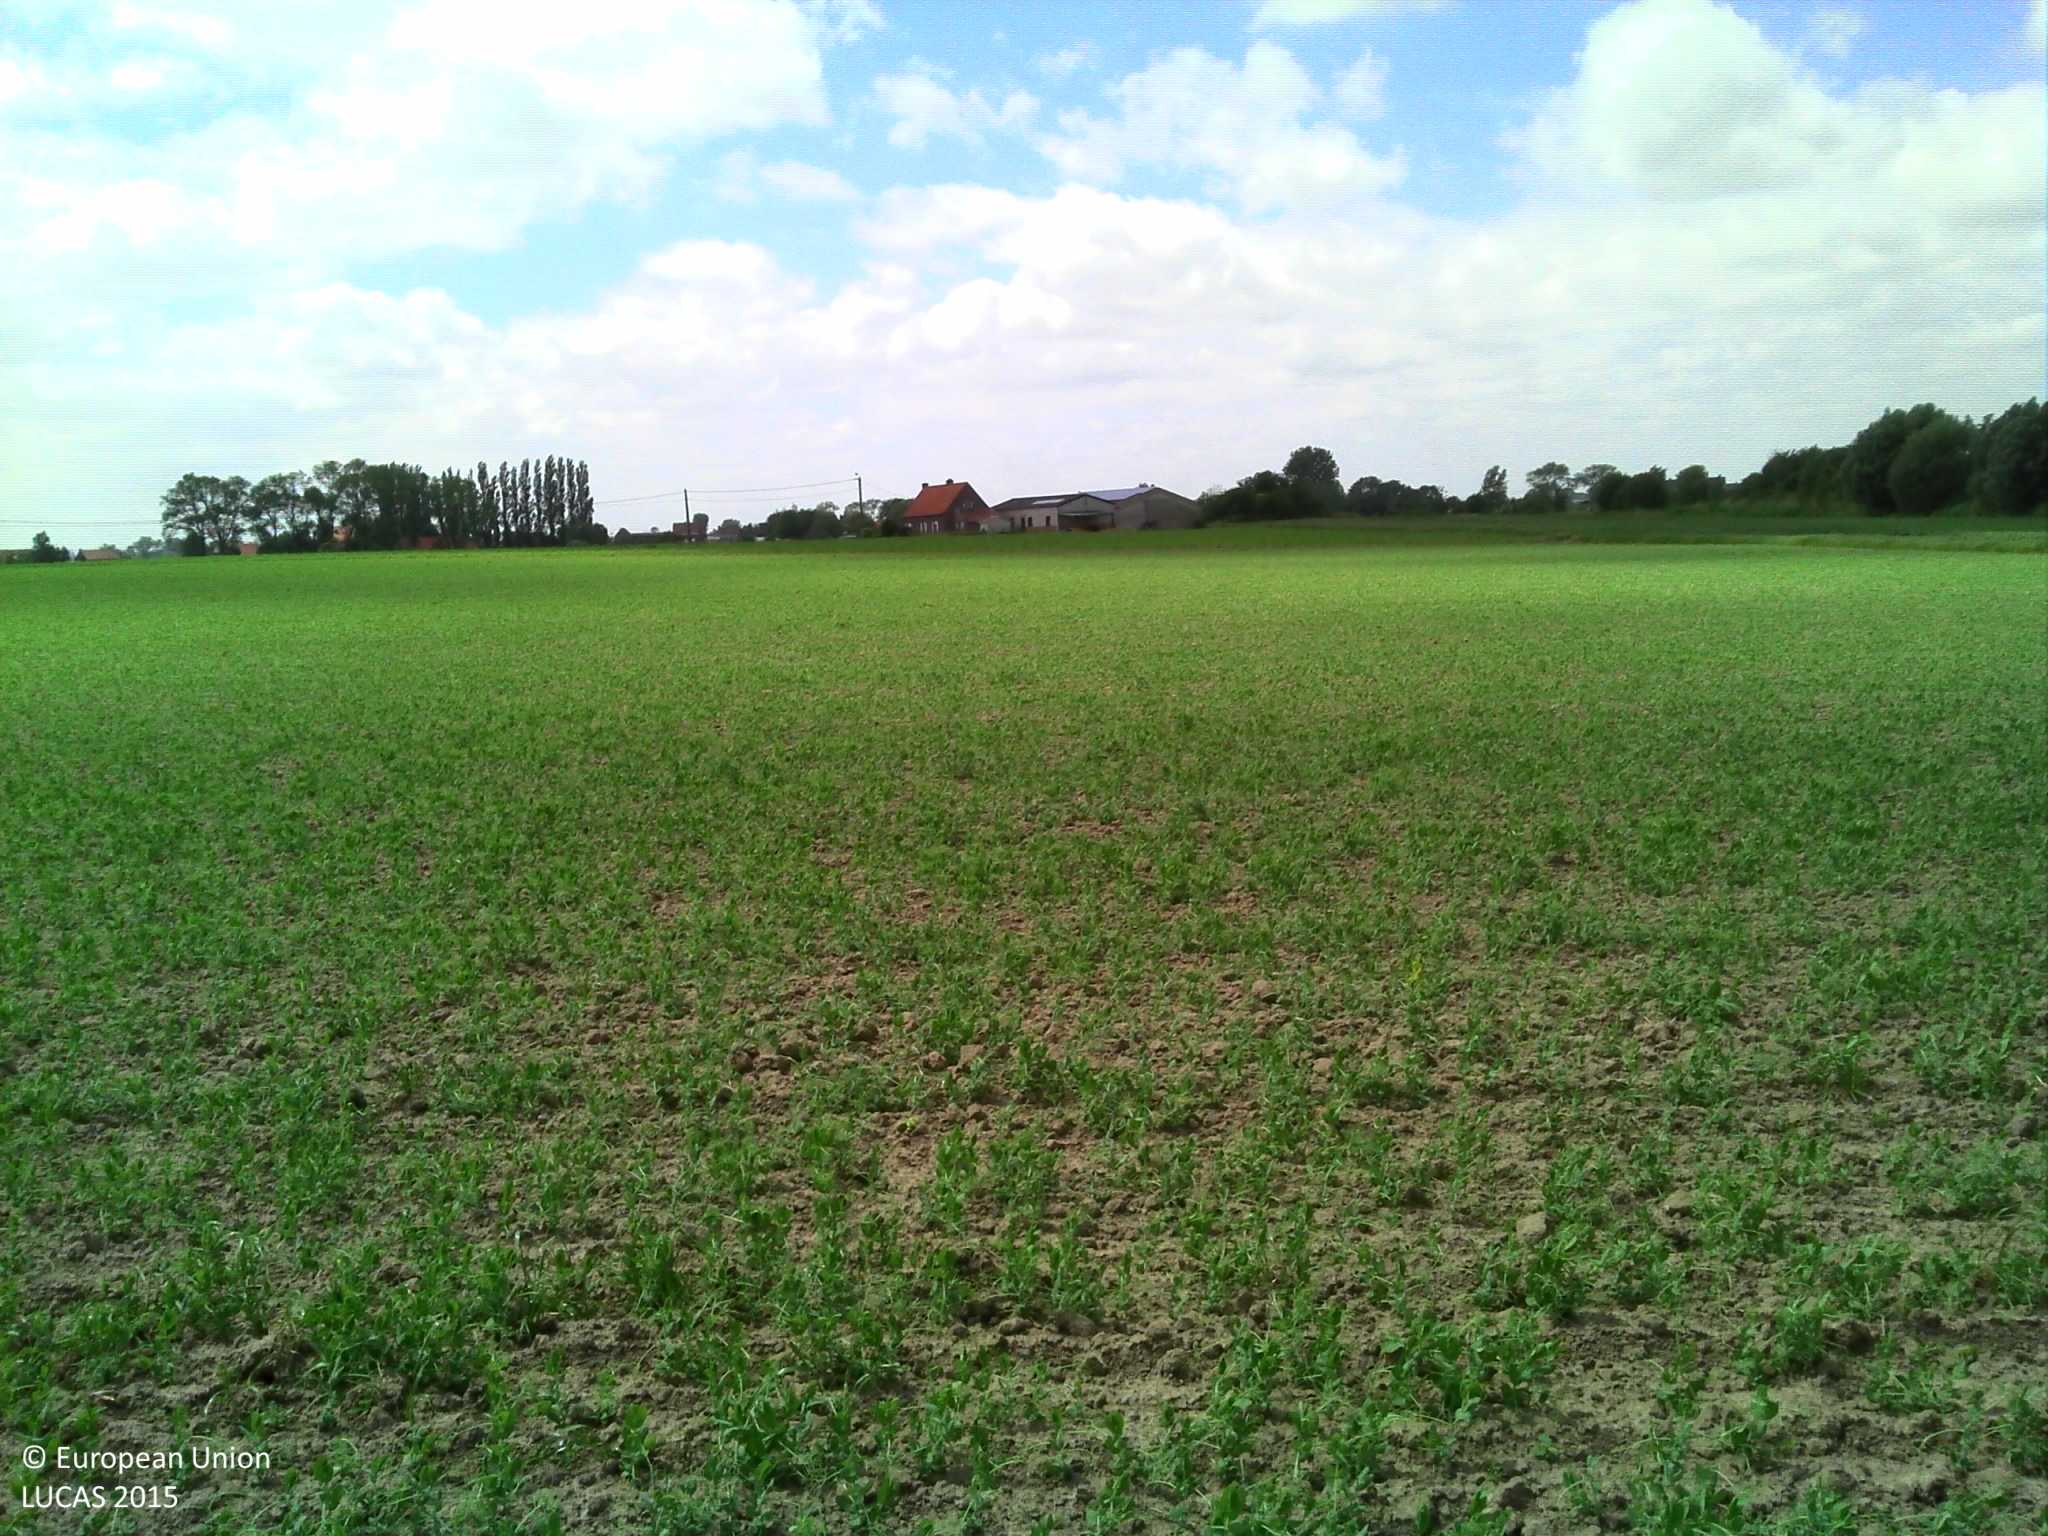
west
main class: Cropland
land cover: Dry pulses
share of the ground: 50 - 75 %
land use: Agriculture (excluding fallow land and kitchen gardens)
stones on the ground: < 10 %
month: June
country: BE
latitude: 51.0221
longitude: 3.1045
